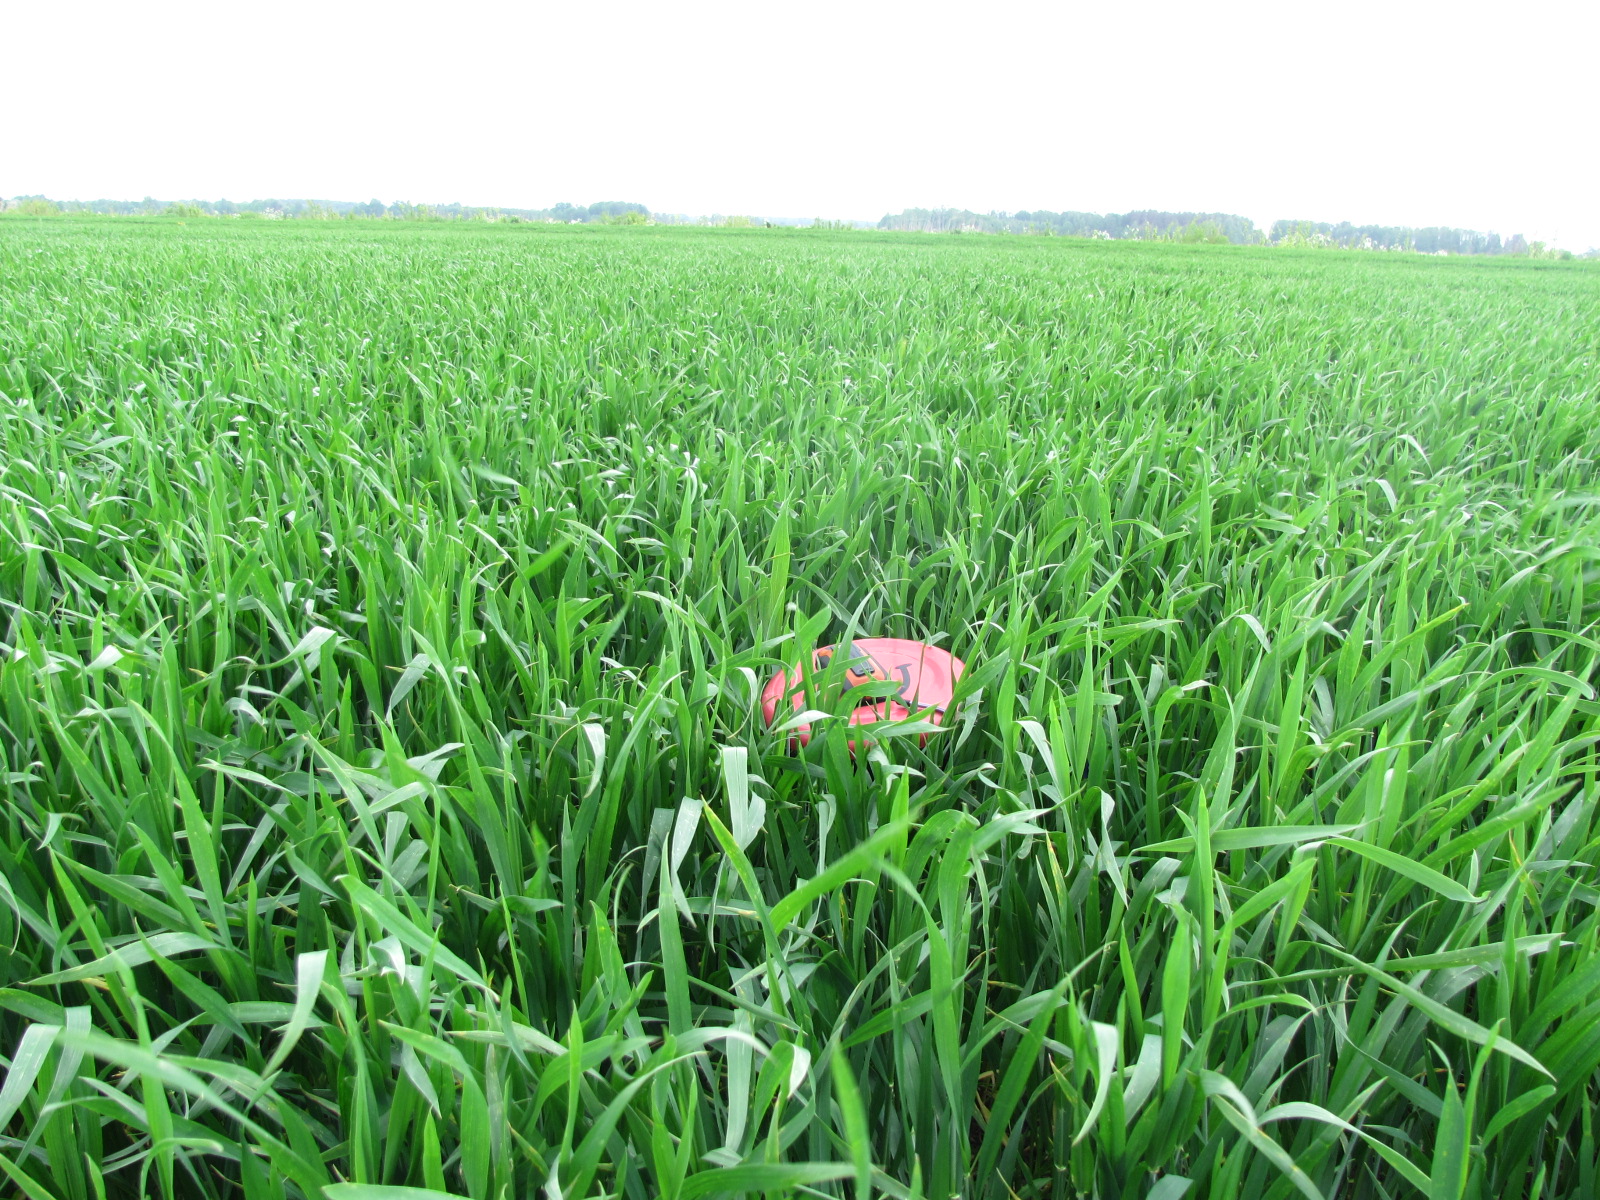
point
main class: Cropland
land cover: Common wheat
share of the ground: > 75 %
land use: Agriculture (excluding fallow land and kitchen gardens)
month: June
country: LV
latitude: 56.7849
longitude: 24.0136
